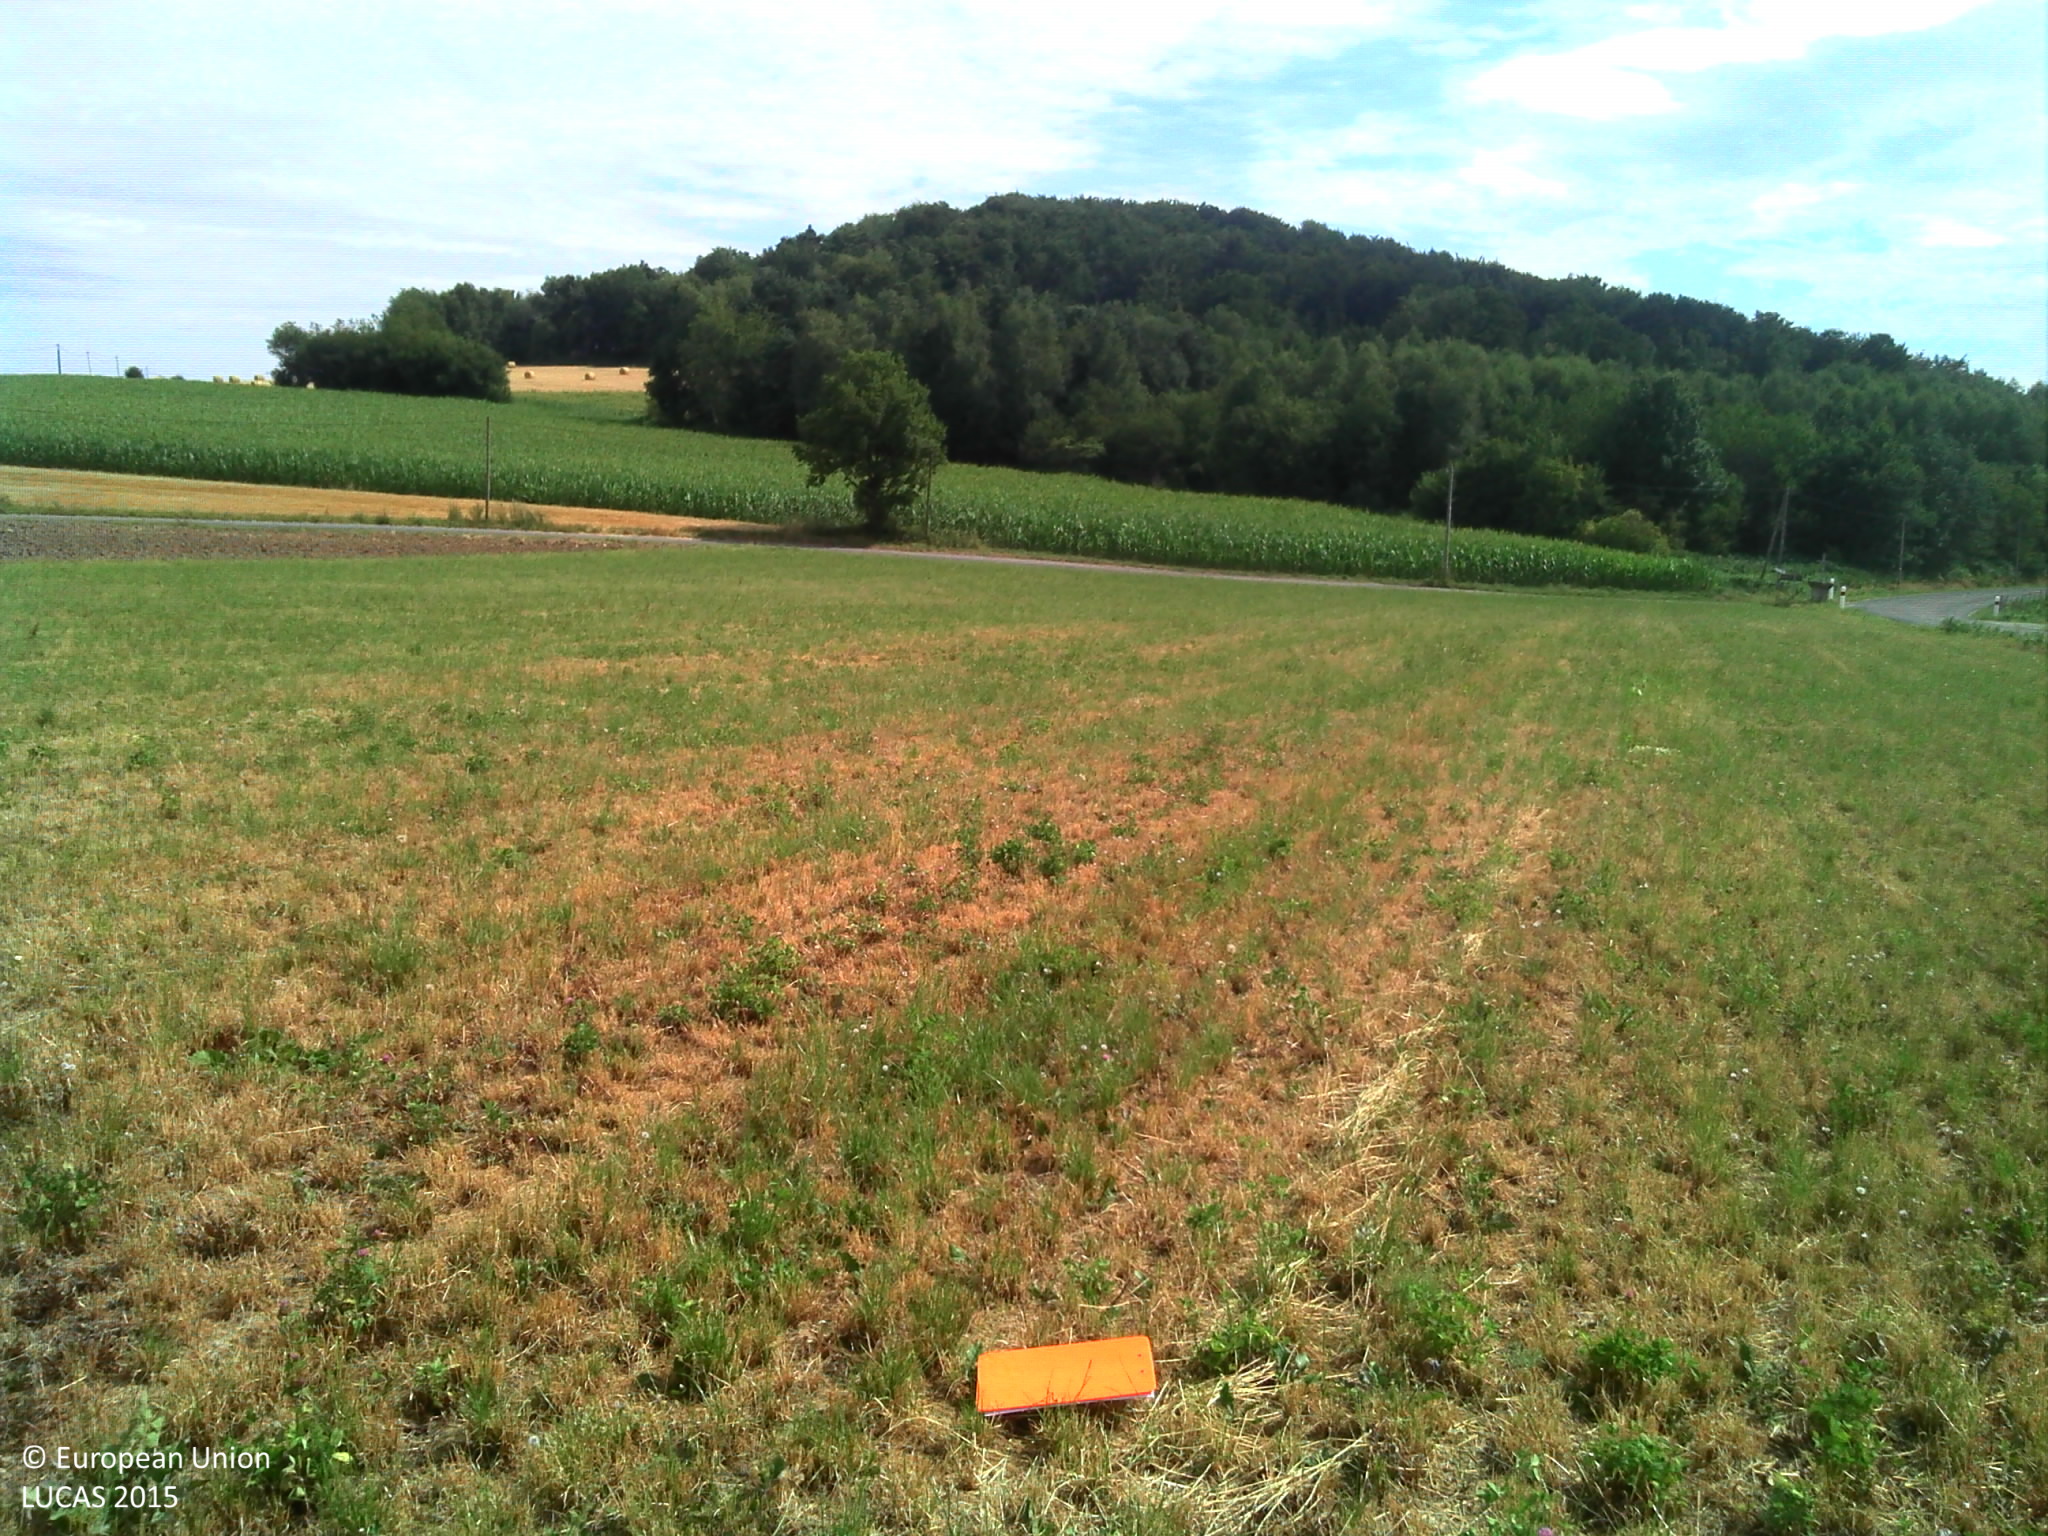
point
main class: Cropland
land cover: Temporary grasslands
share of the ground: > 75 %
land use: Agriculture (excluding fallow land and kitchen gardens)
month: July
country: FR
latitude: 45.5781
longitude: 4.5058
